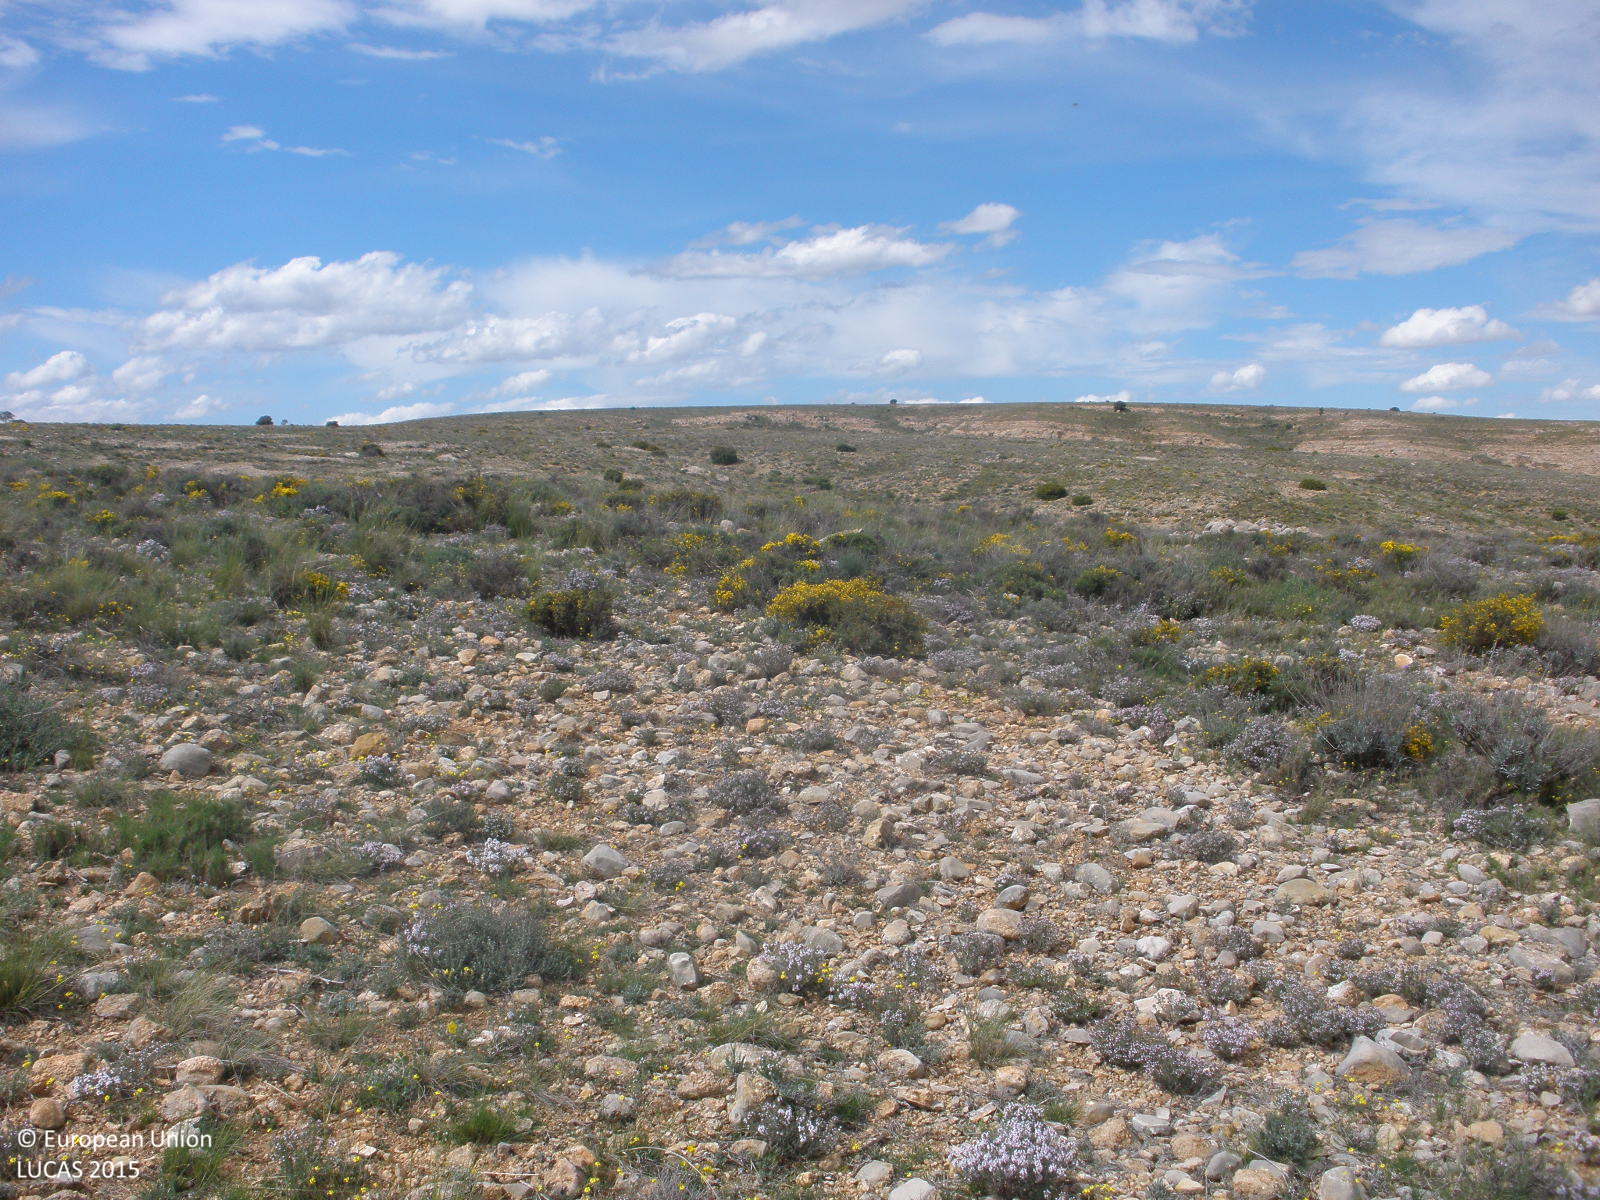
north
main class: Shrubland
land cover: Shrubland without tree cover
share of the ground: 25 - 50 %
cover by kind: shrubs 40 %, herbaceous plants 30 %, consolidated bare surface 30 %
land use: Semi-natural and natural areas not in use
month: May
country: ES
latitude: 41.0386
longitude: -0.9484
